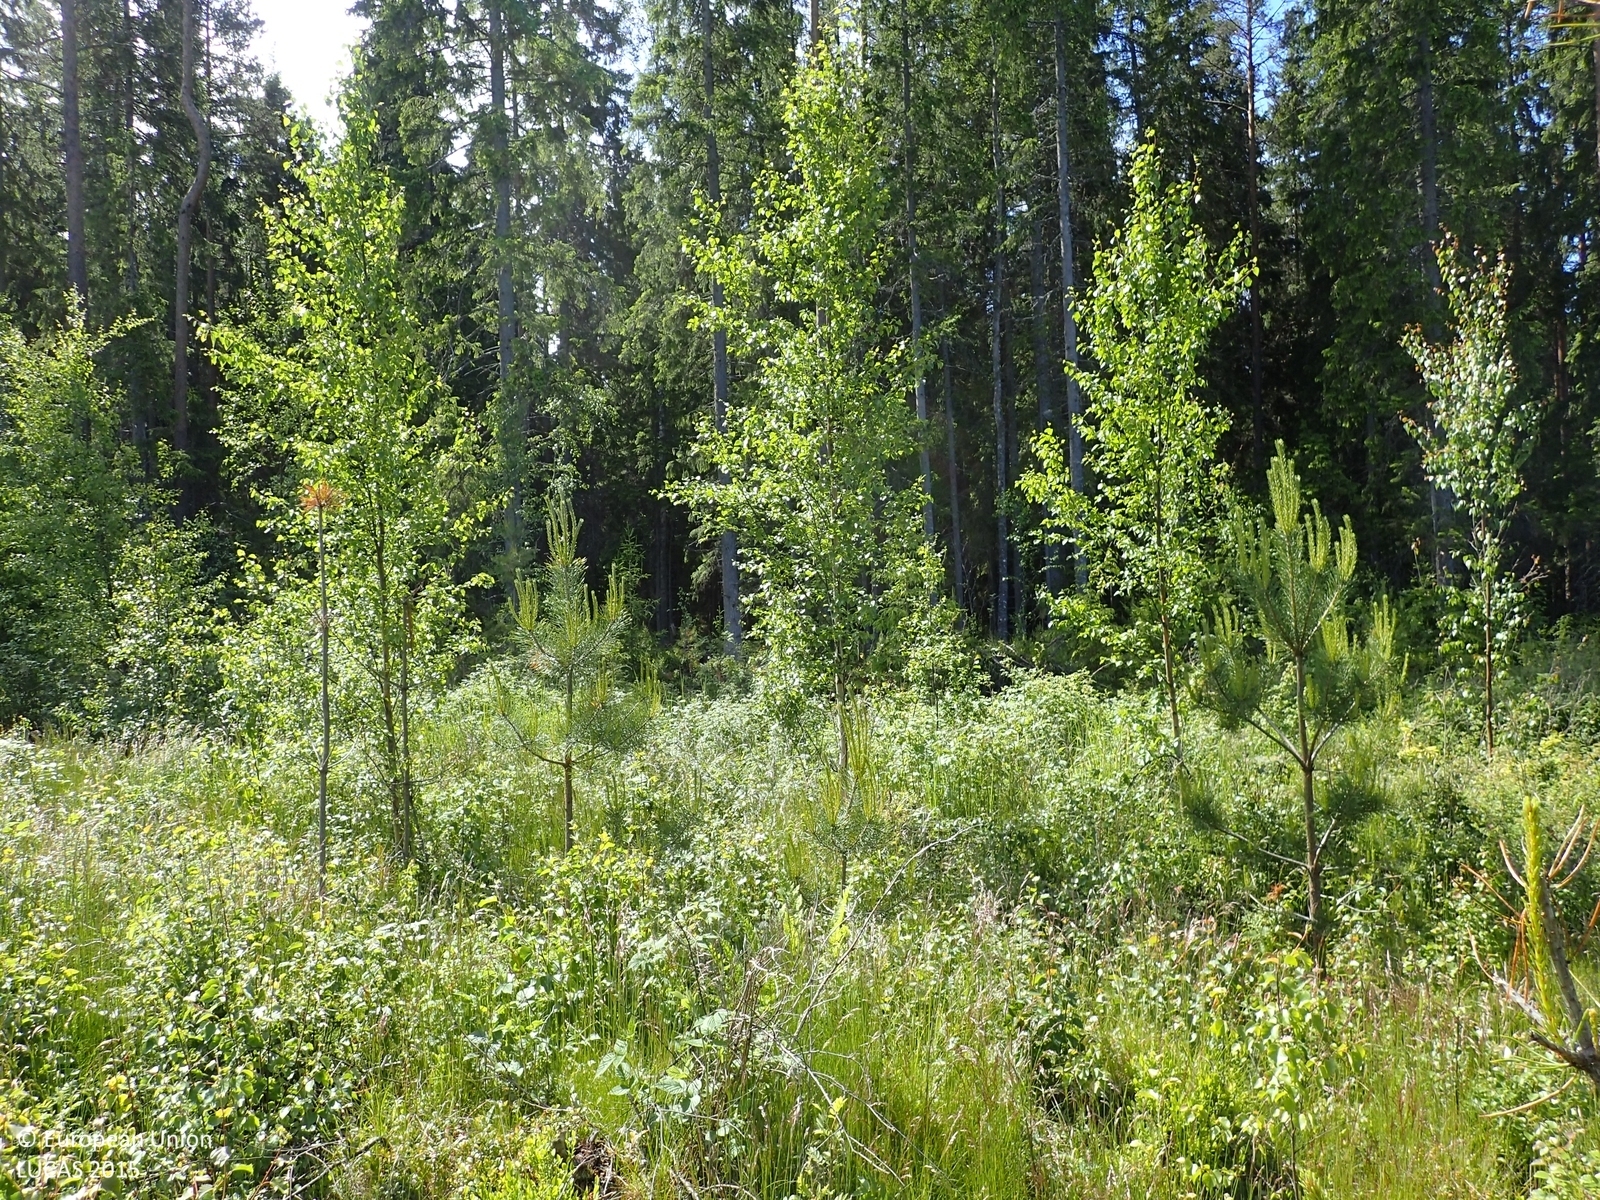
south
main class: Woodland
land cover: Pine dominated mixed woodland
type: boreal forest
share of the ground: 25 - 50 %
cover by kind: herbaceous plants 60 %, coniferous forest trees 15 %, broadleaved forest trees 15 %, shrubs 10 %
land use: Forestry
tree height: < 5 m
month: June
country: FI
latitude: 62.3794
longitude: 21.3924
